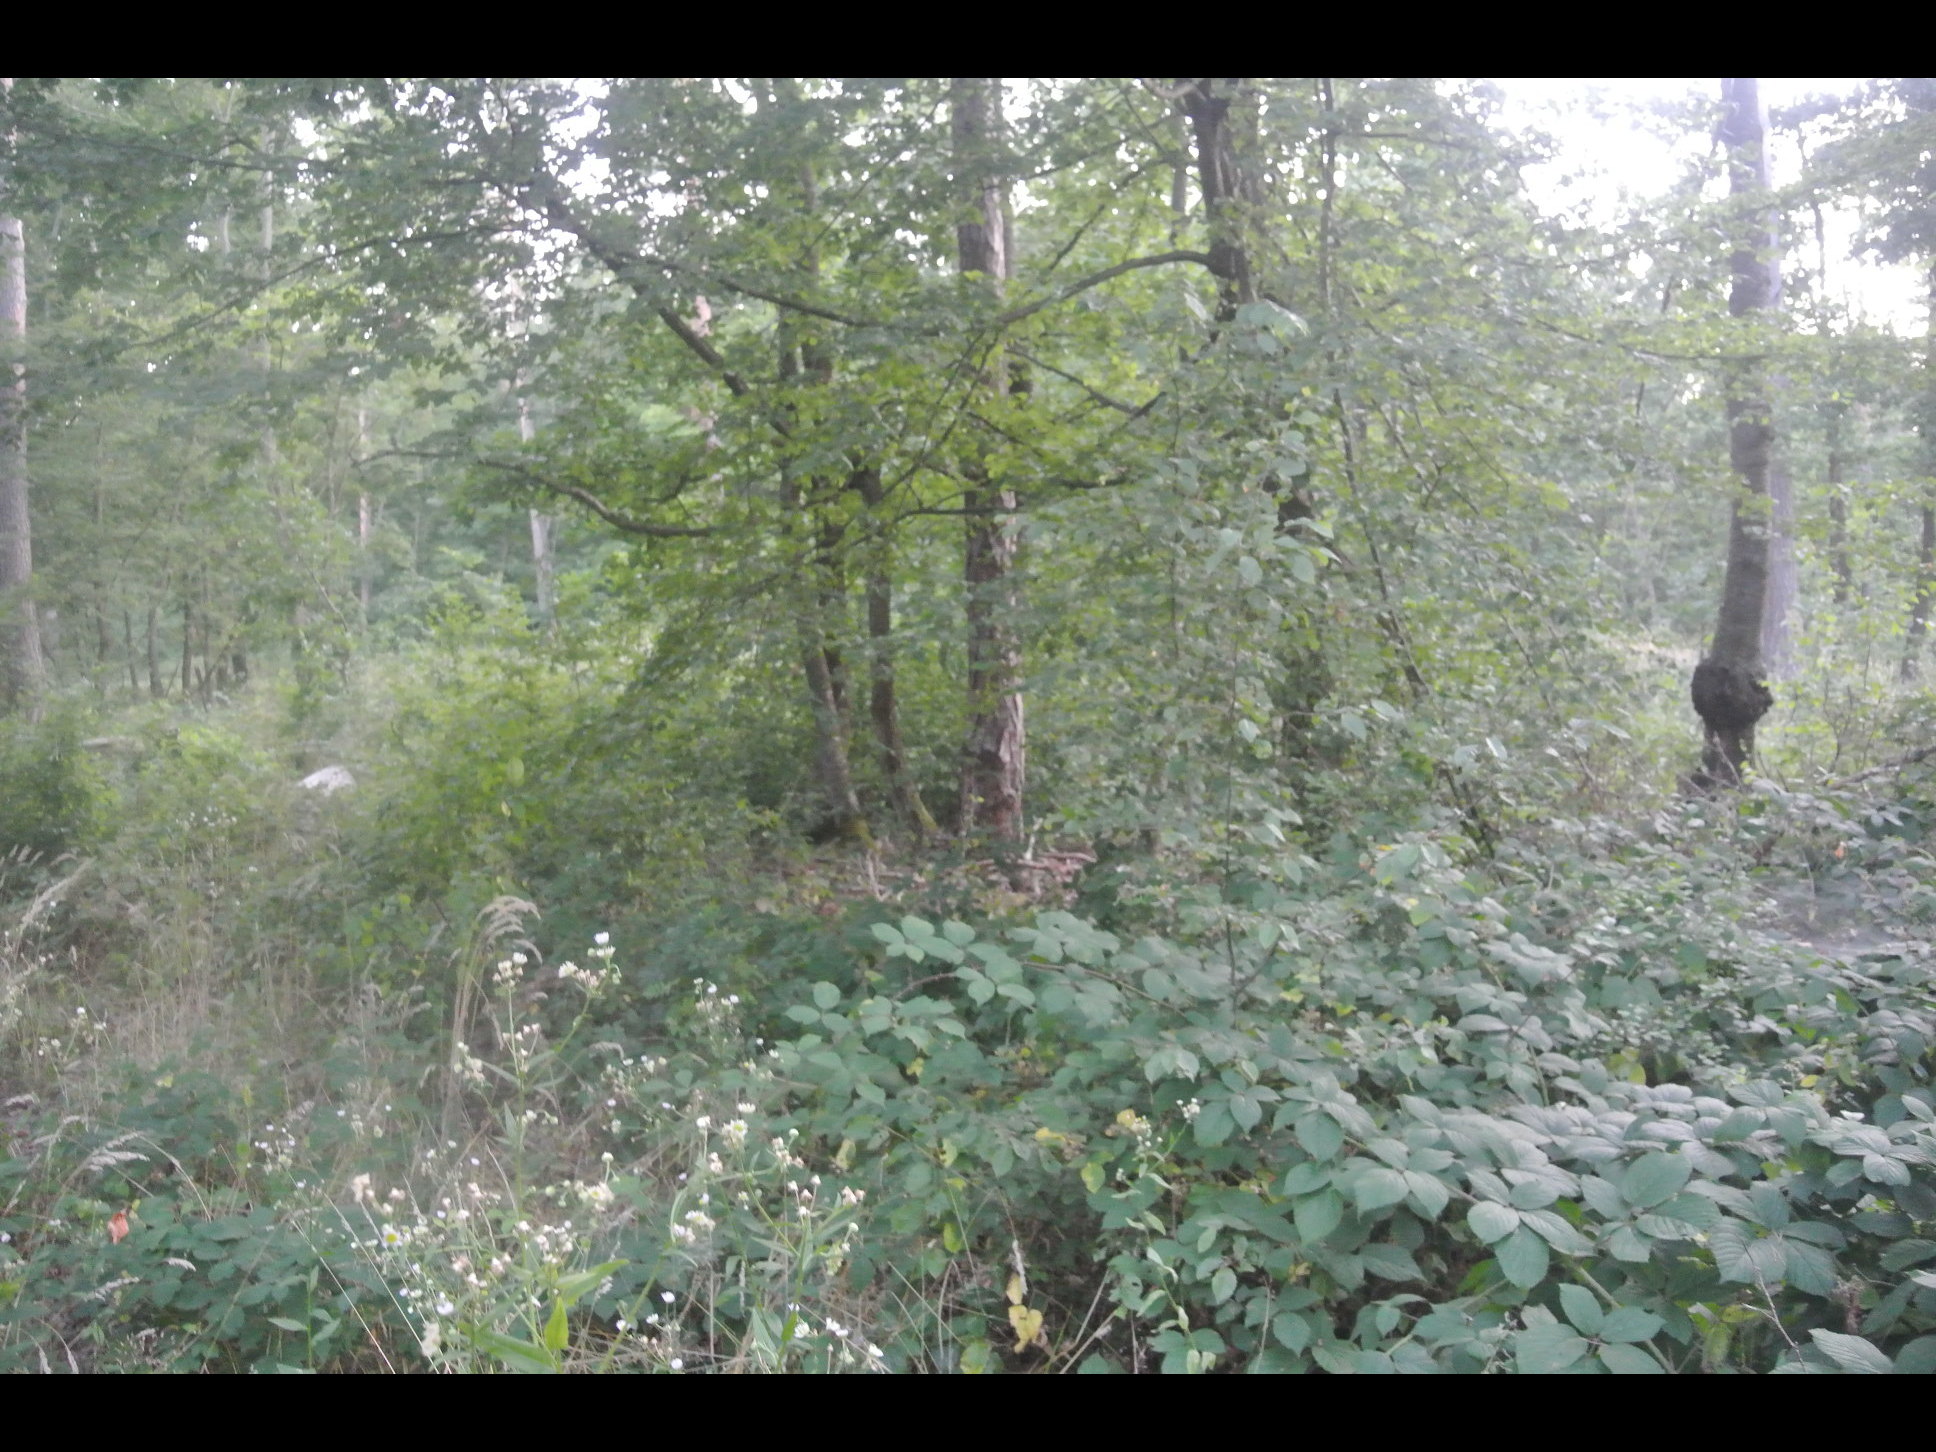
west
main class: Woodland
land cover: Pine dominated mixed woodland
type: alpine coniferous forest
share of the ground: > 75 %
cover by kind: broadleaved forest trees 75 %, coniferous forest trees 25 %
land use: Forestry
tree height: > 5 m
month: July
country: AT
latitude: 47.5832
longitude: 16.4525
